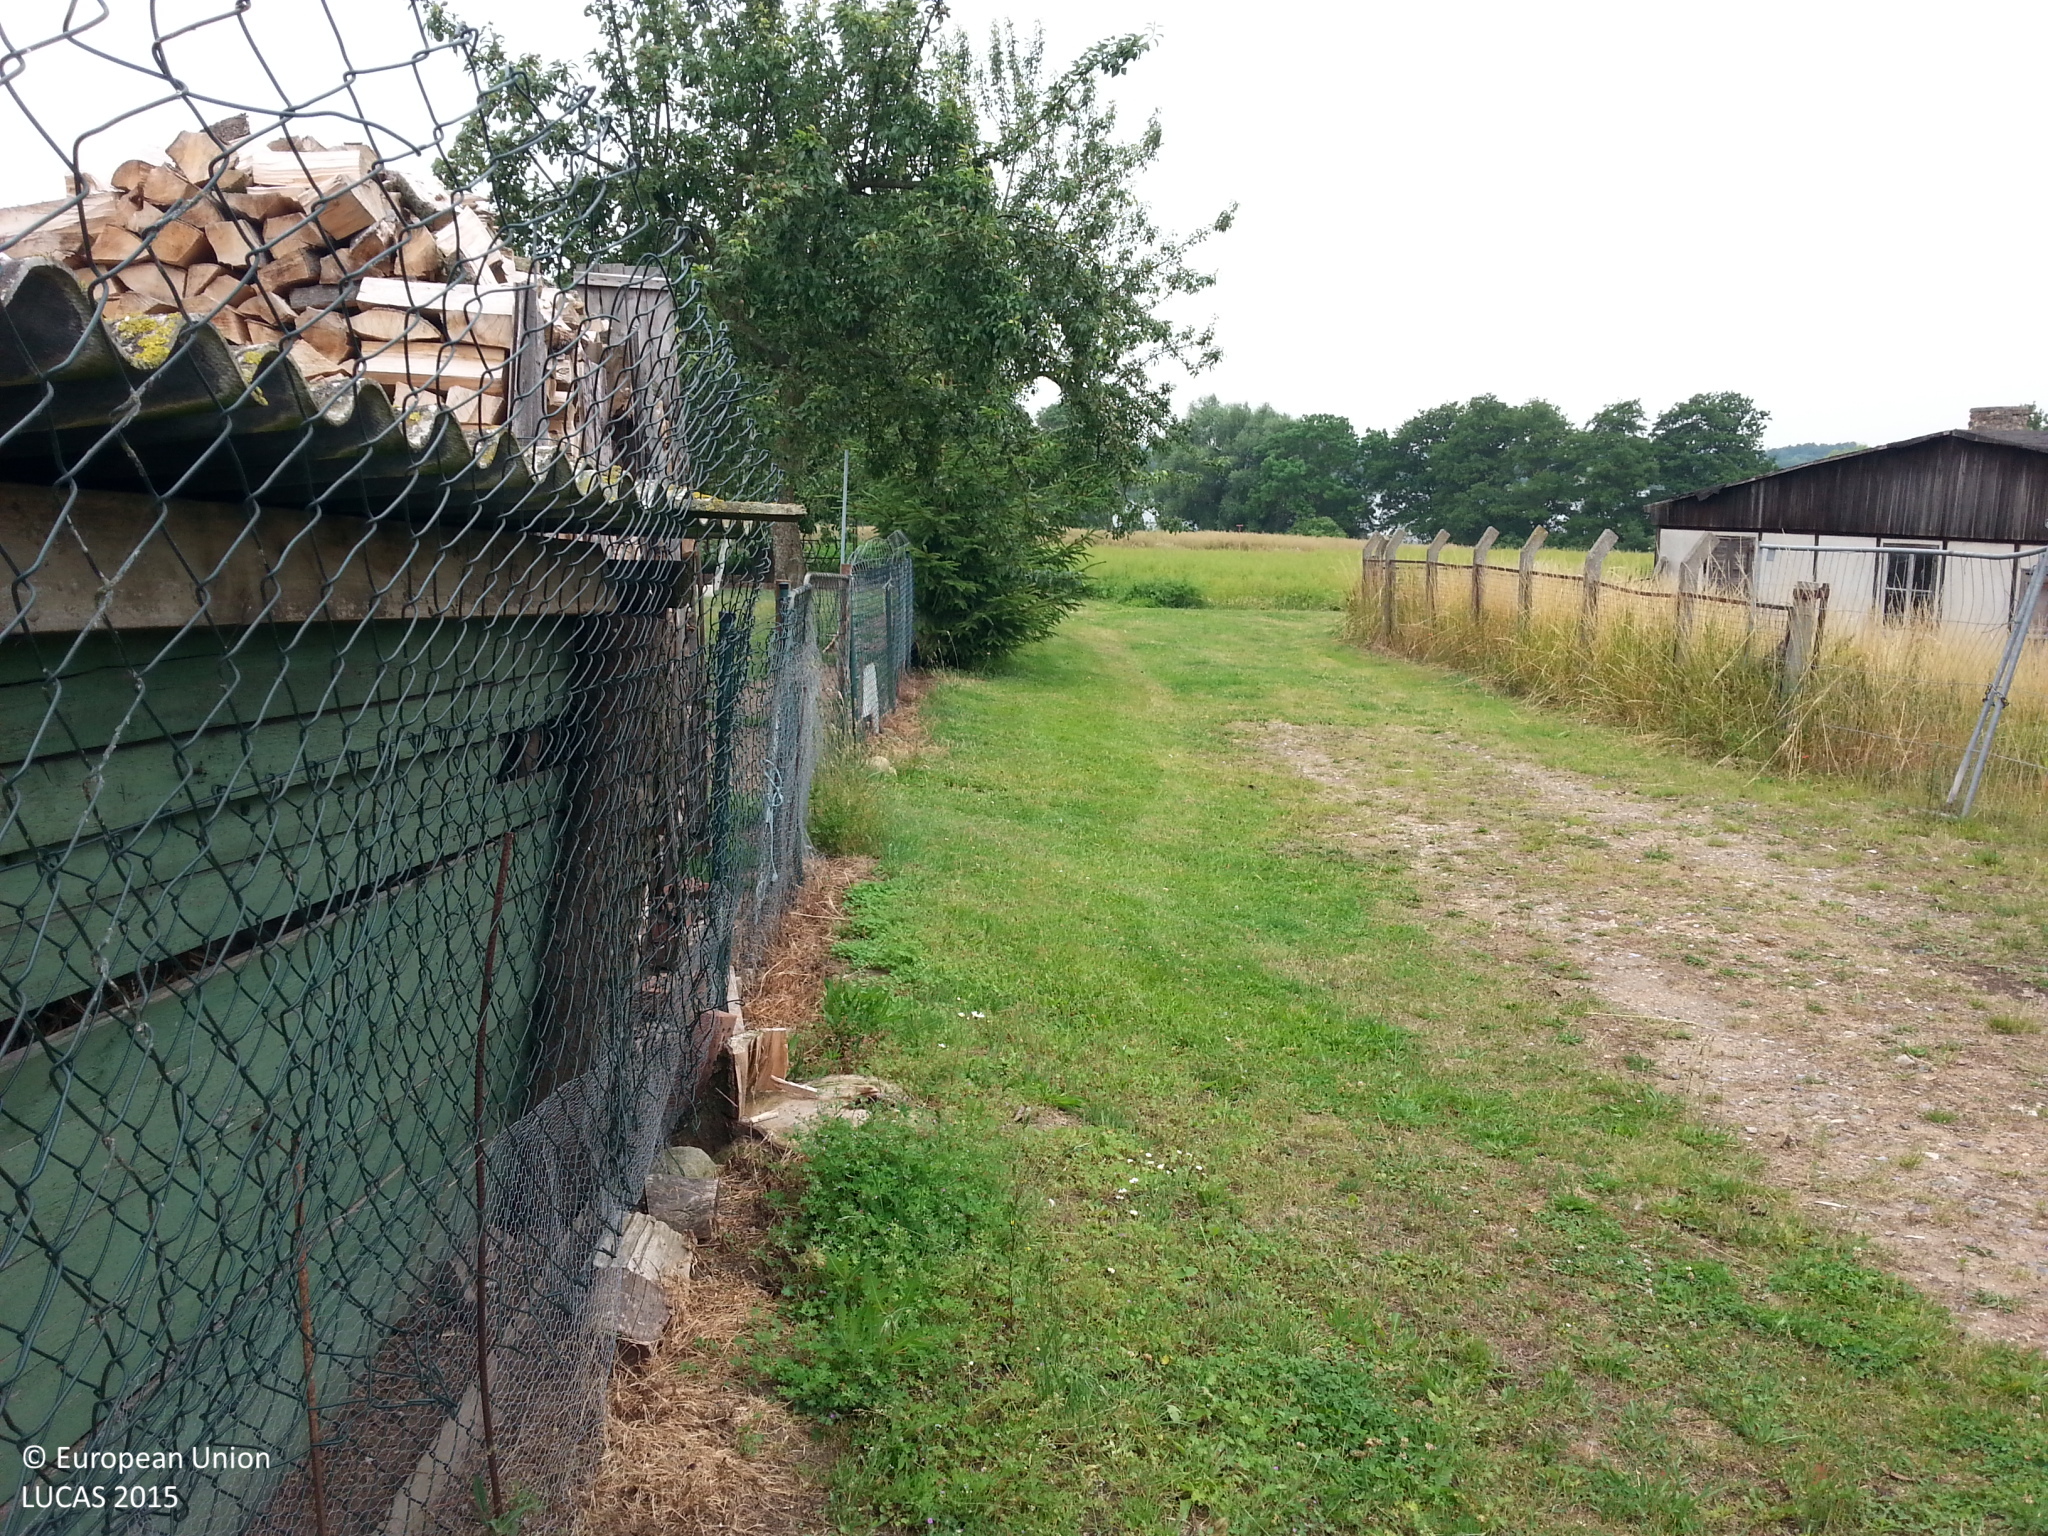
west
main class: Cropland
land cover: Apple fruit
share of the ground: 10 - 25 %
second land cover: Grassland without tree/shrub cover
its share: 50 - 75 %
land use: Agriculture (excluding fallow land and kitchen gardens)
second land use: Residential
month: July
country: DE
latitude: 53.6975
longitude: 11.5593
